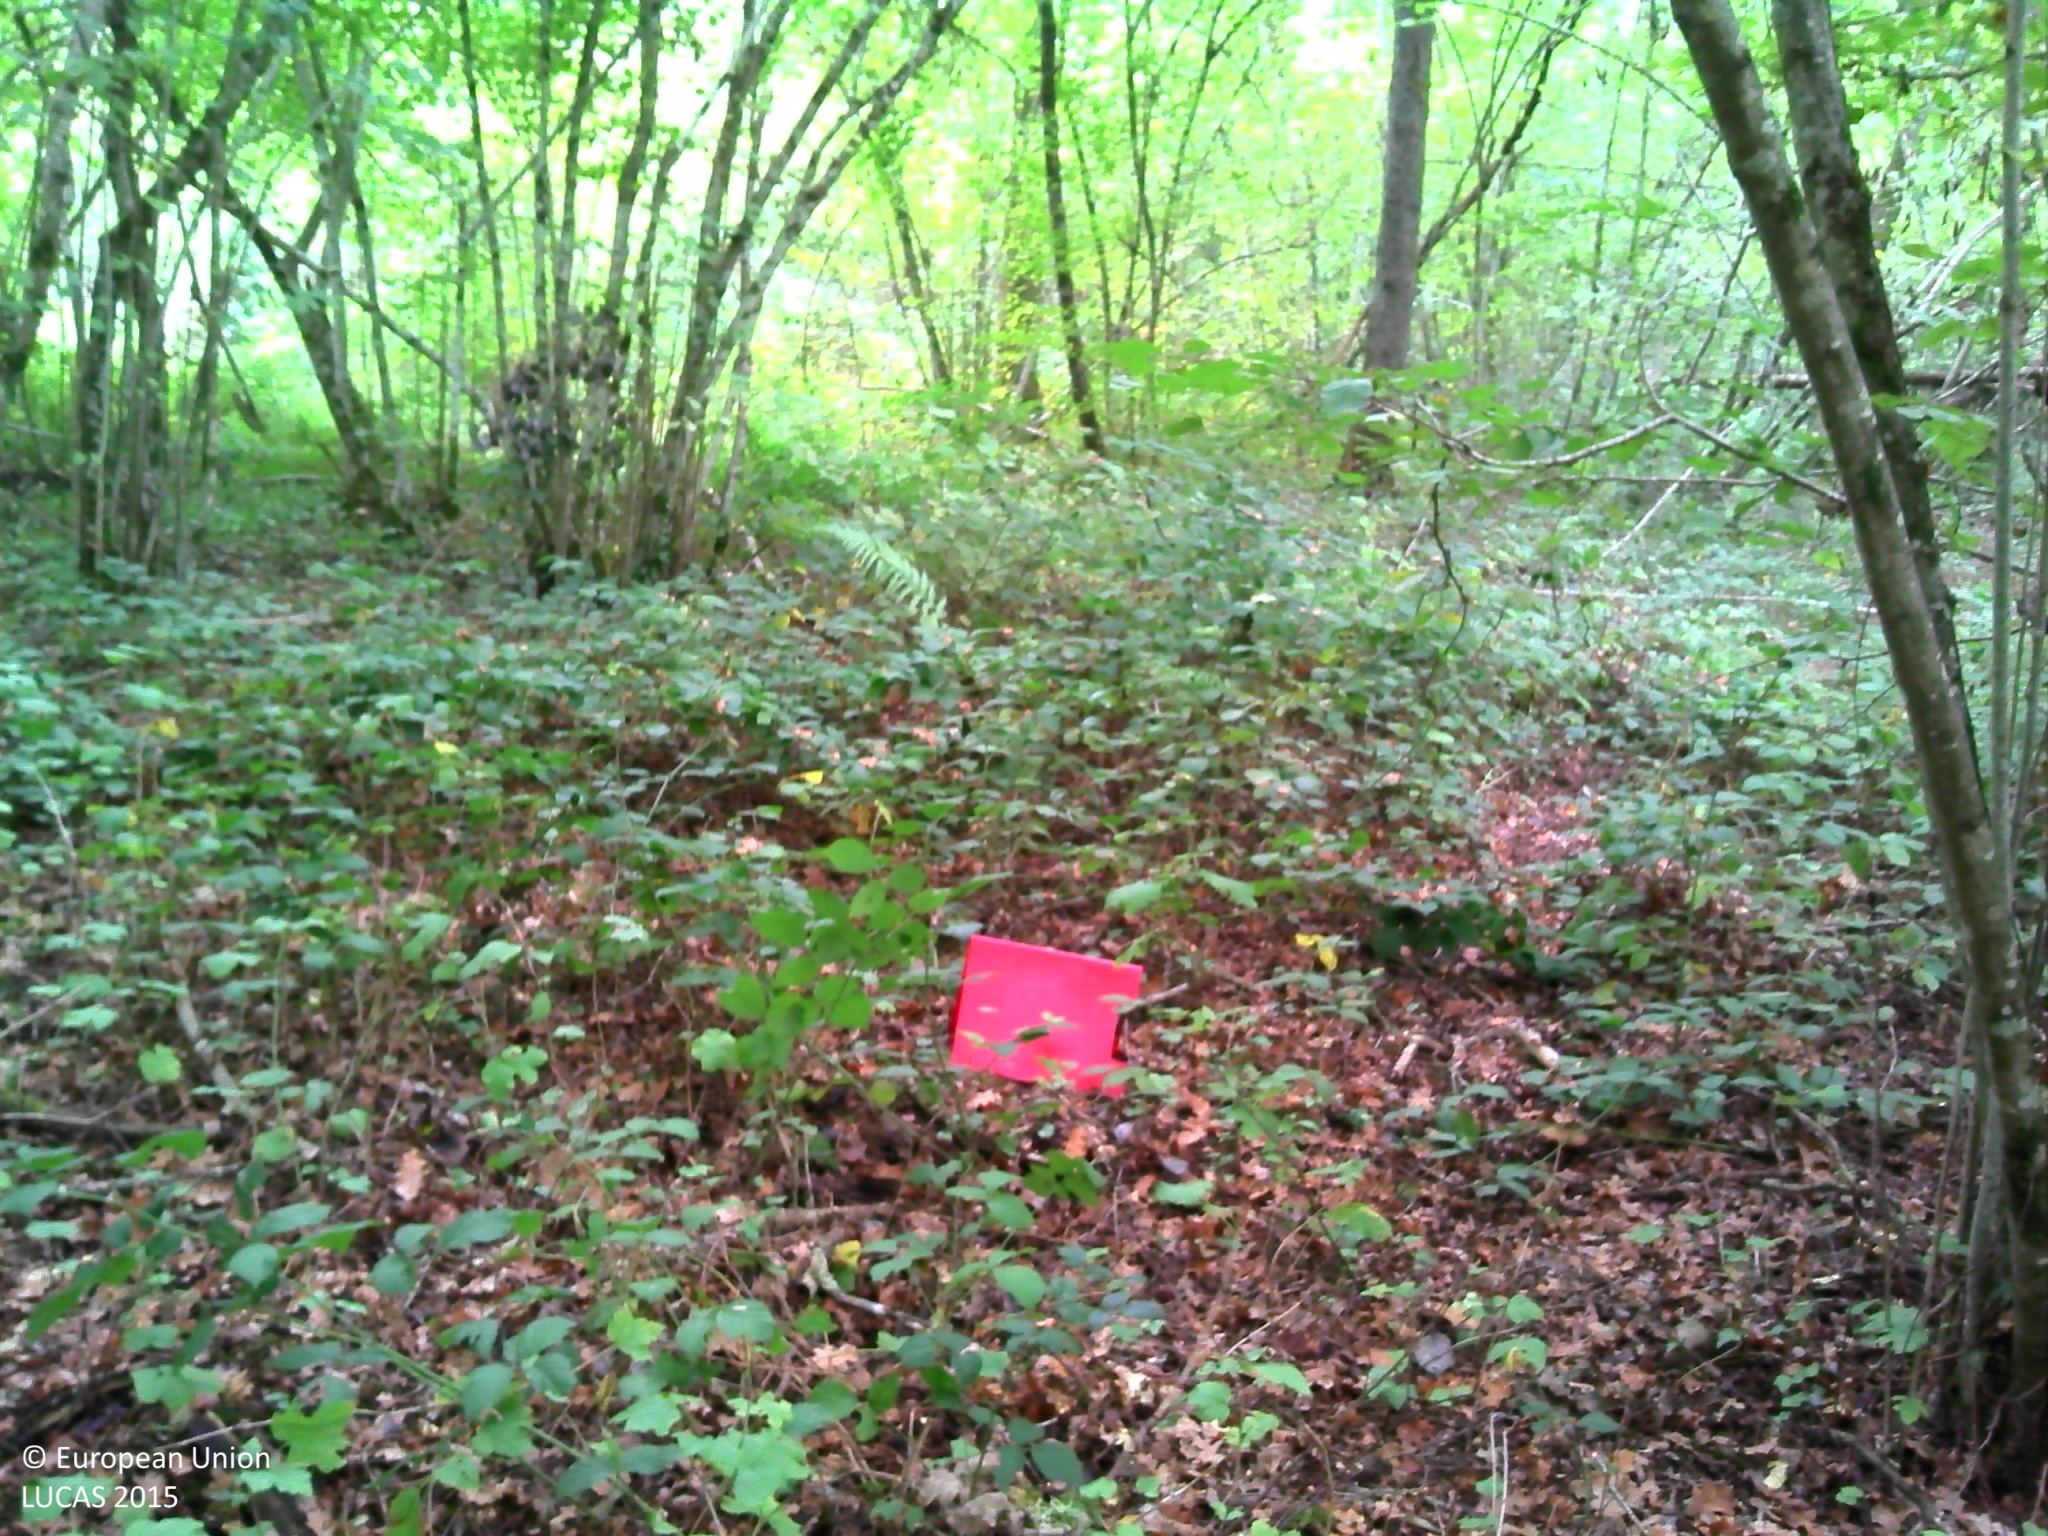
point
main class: Woodland
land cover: Broadleaved woodland
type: mesophytic deciduous forest
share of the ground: > 75 %
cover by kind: broadleaved forest trees 90 %, herbaceous plants 10 %
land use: Forestry
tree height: > 5 m
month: October
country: FR
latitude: 46.2755
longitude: 5.1104
